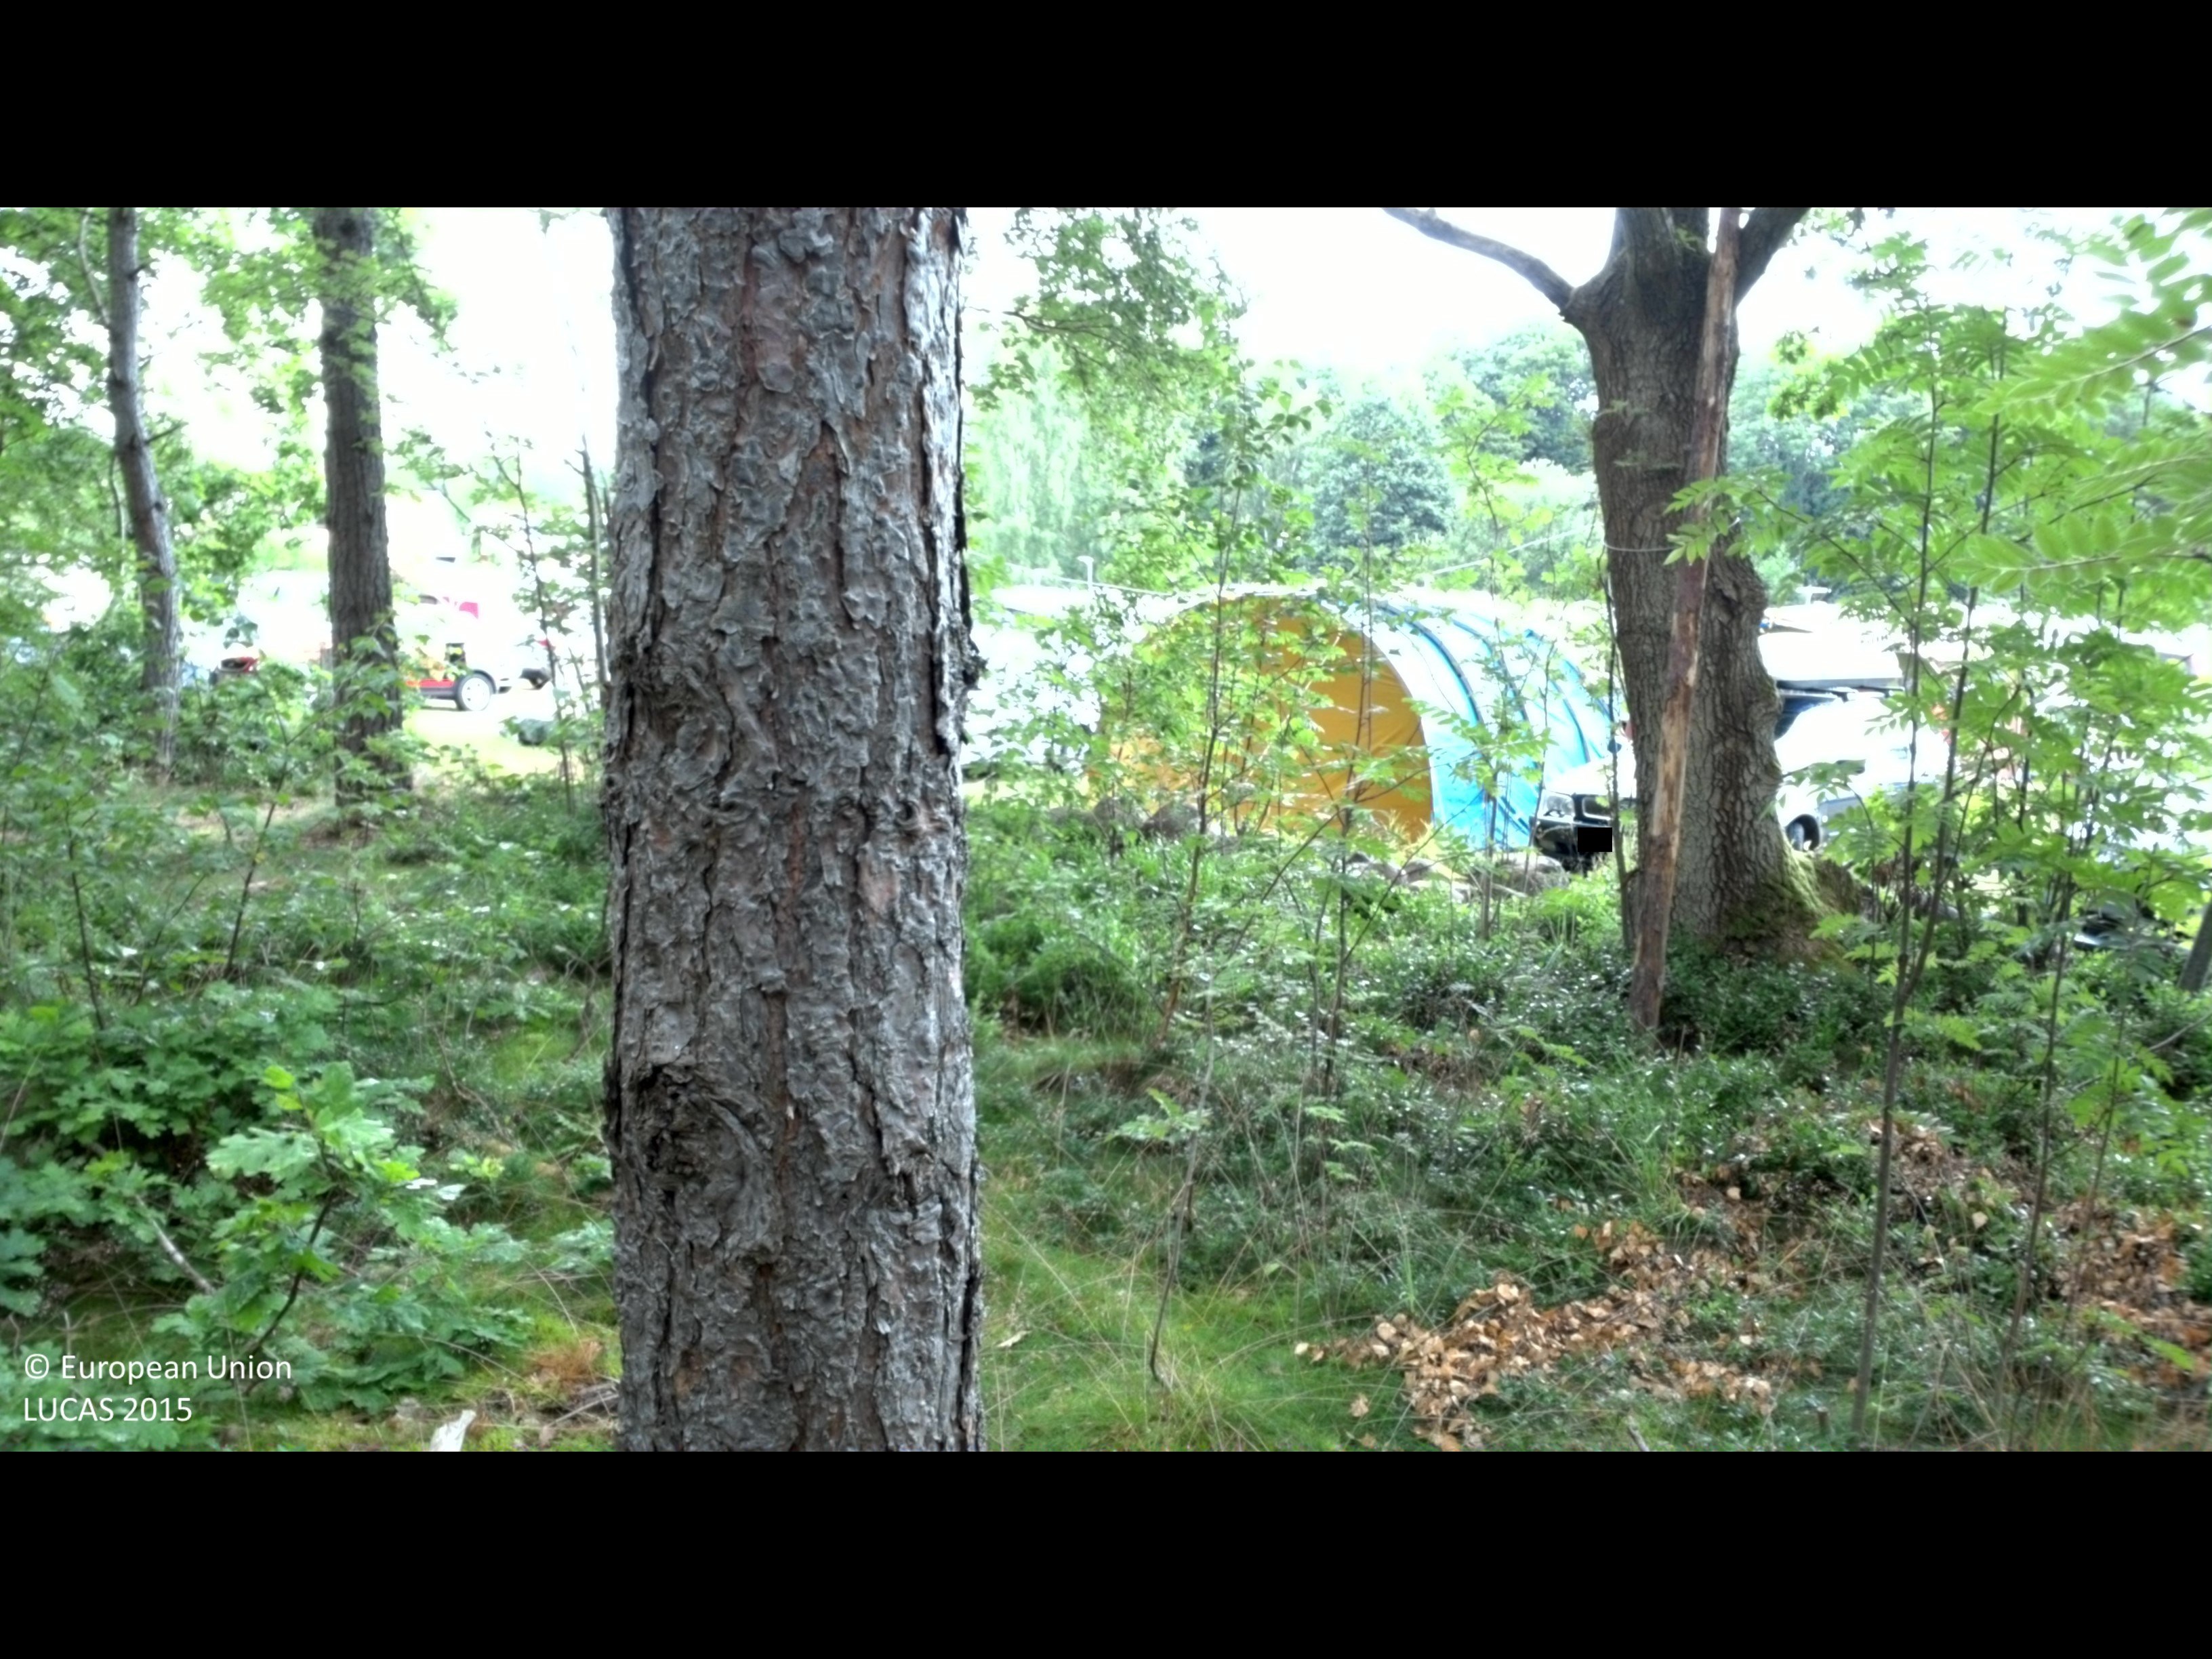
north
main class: Woodland
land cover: Pine dominated coniferous woodland
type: boreal forest
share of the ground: 50 - 75 %
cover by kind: coniferous forest trees 65 %, shrubs 20 %, broadleaved forest trees 10 %, herbaceous plants 5 %
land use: Forestry
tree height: > 5 m
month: July
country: SE
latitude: 57.2579
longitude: 17.0473
